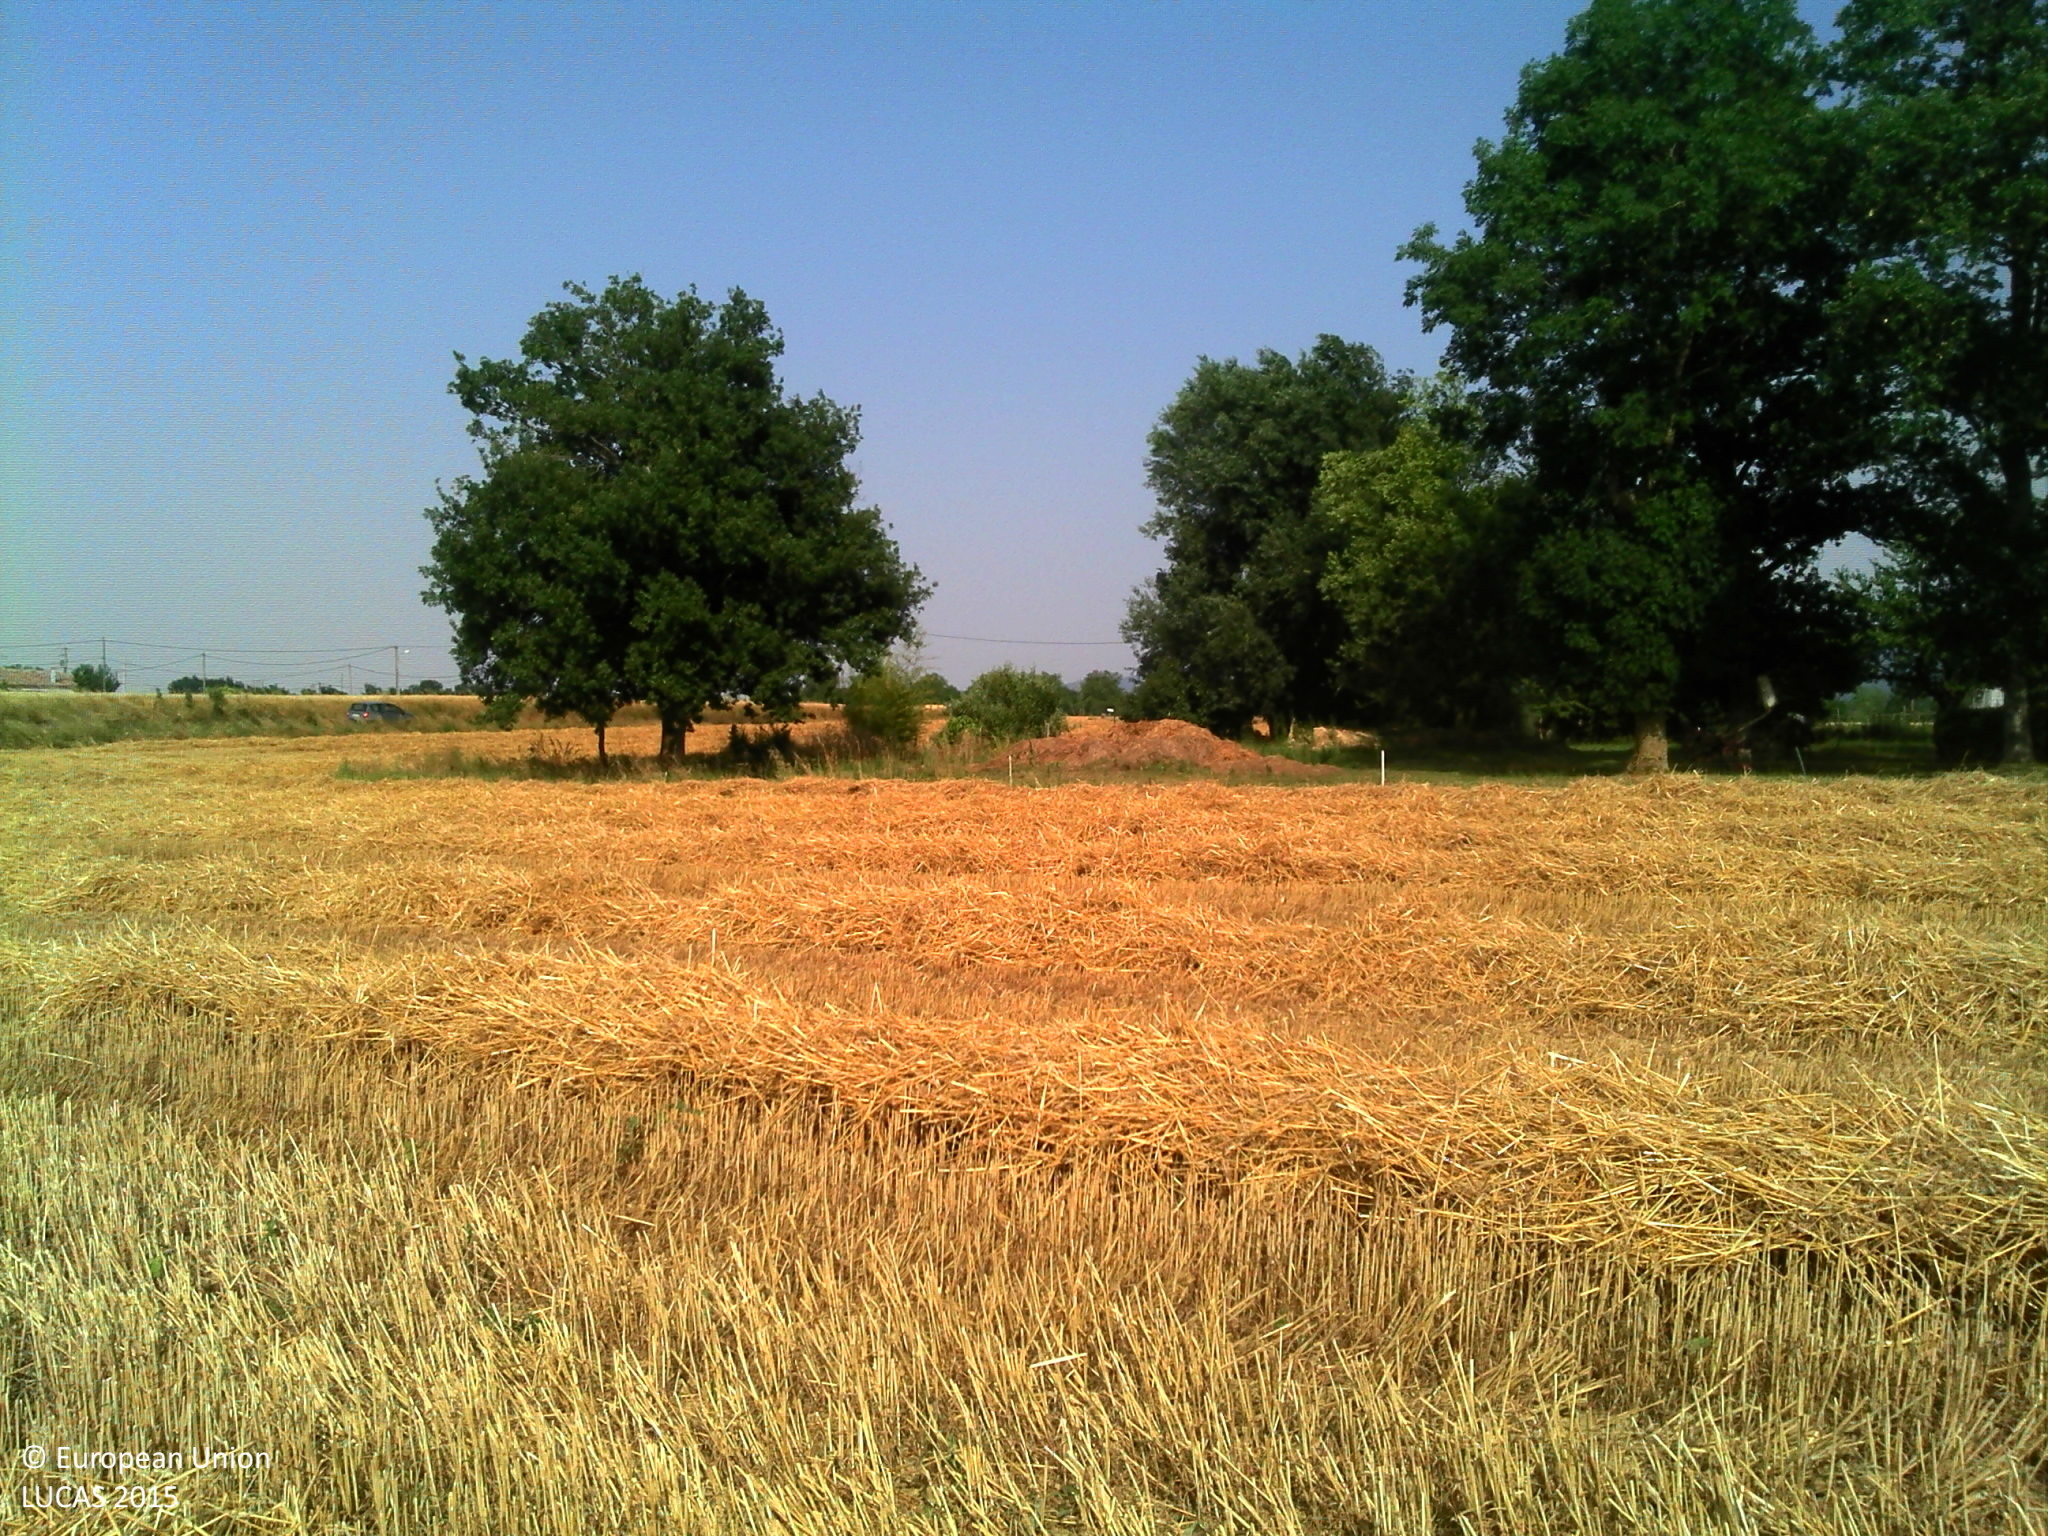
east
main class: Cropland
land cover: Common wheat
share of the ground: > 75 %
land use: Agriculture (excluding fallow land and kitchen gardens)
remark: Harvested field
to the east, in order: Common wheat; Grassland without tree/shrub cover; Single bushes/trees; Ditches and canals; Common wheat; Ditches and canals; Grass margins; Paved roads, cycling and walking lanes; Grass margins; Common wheat
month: July
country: FR
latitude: 43.4801
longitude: 2.0064
